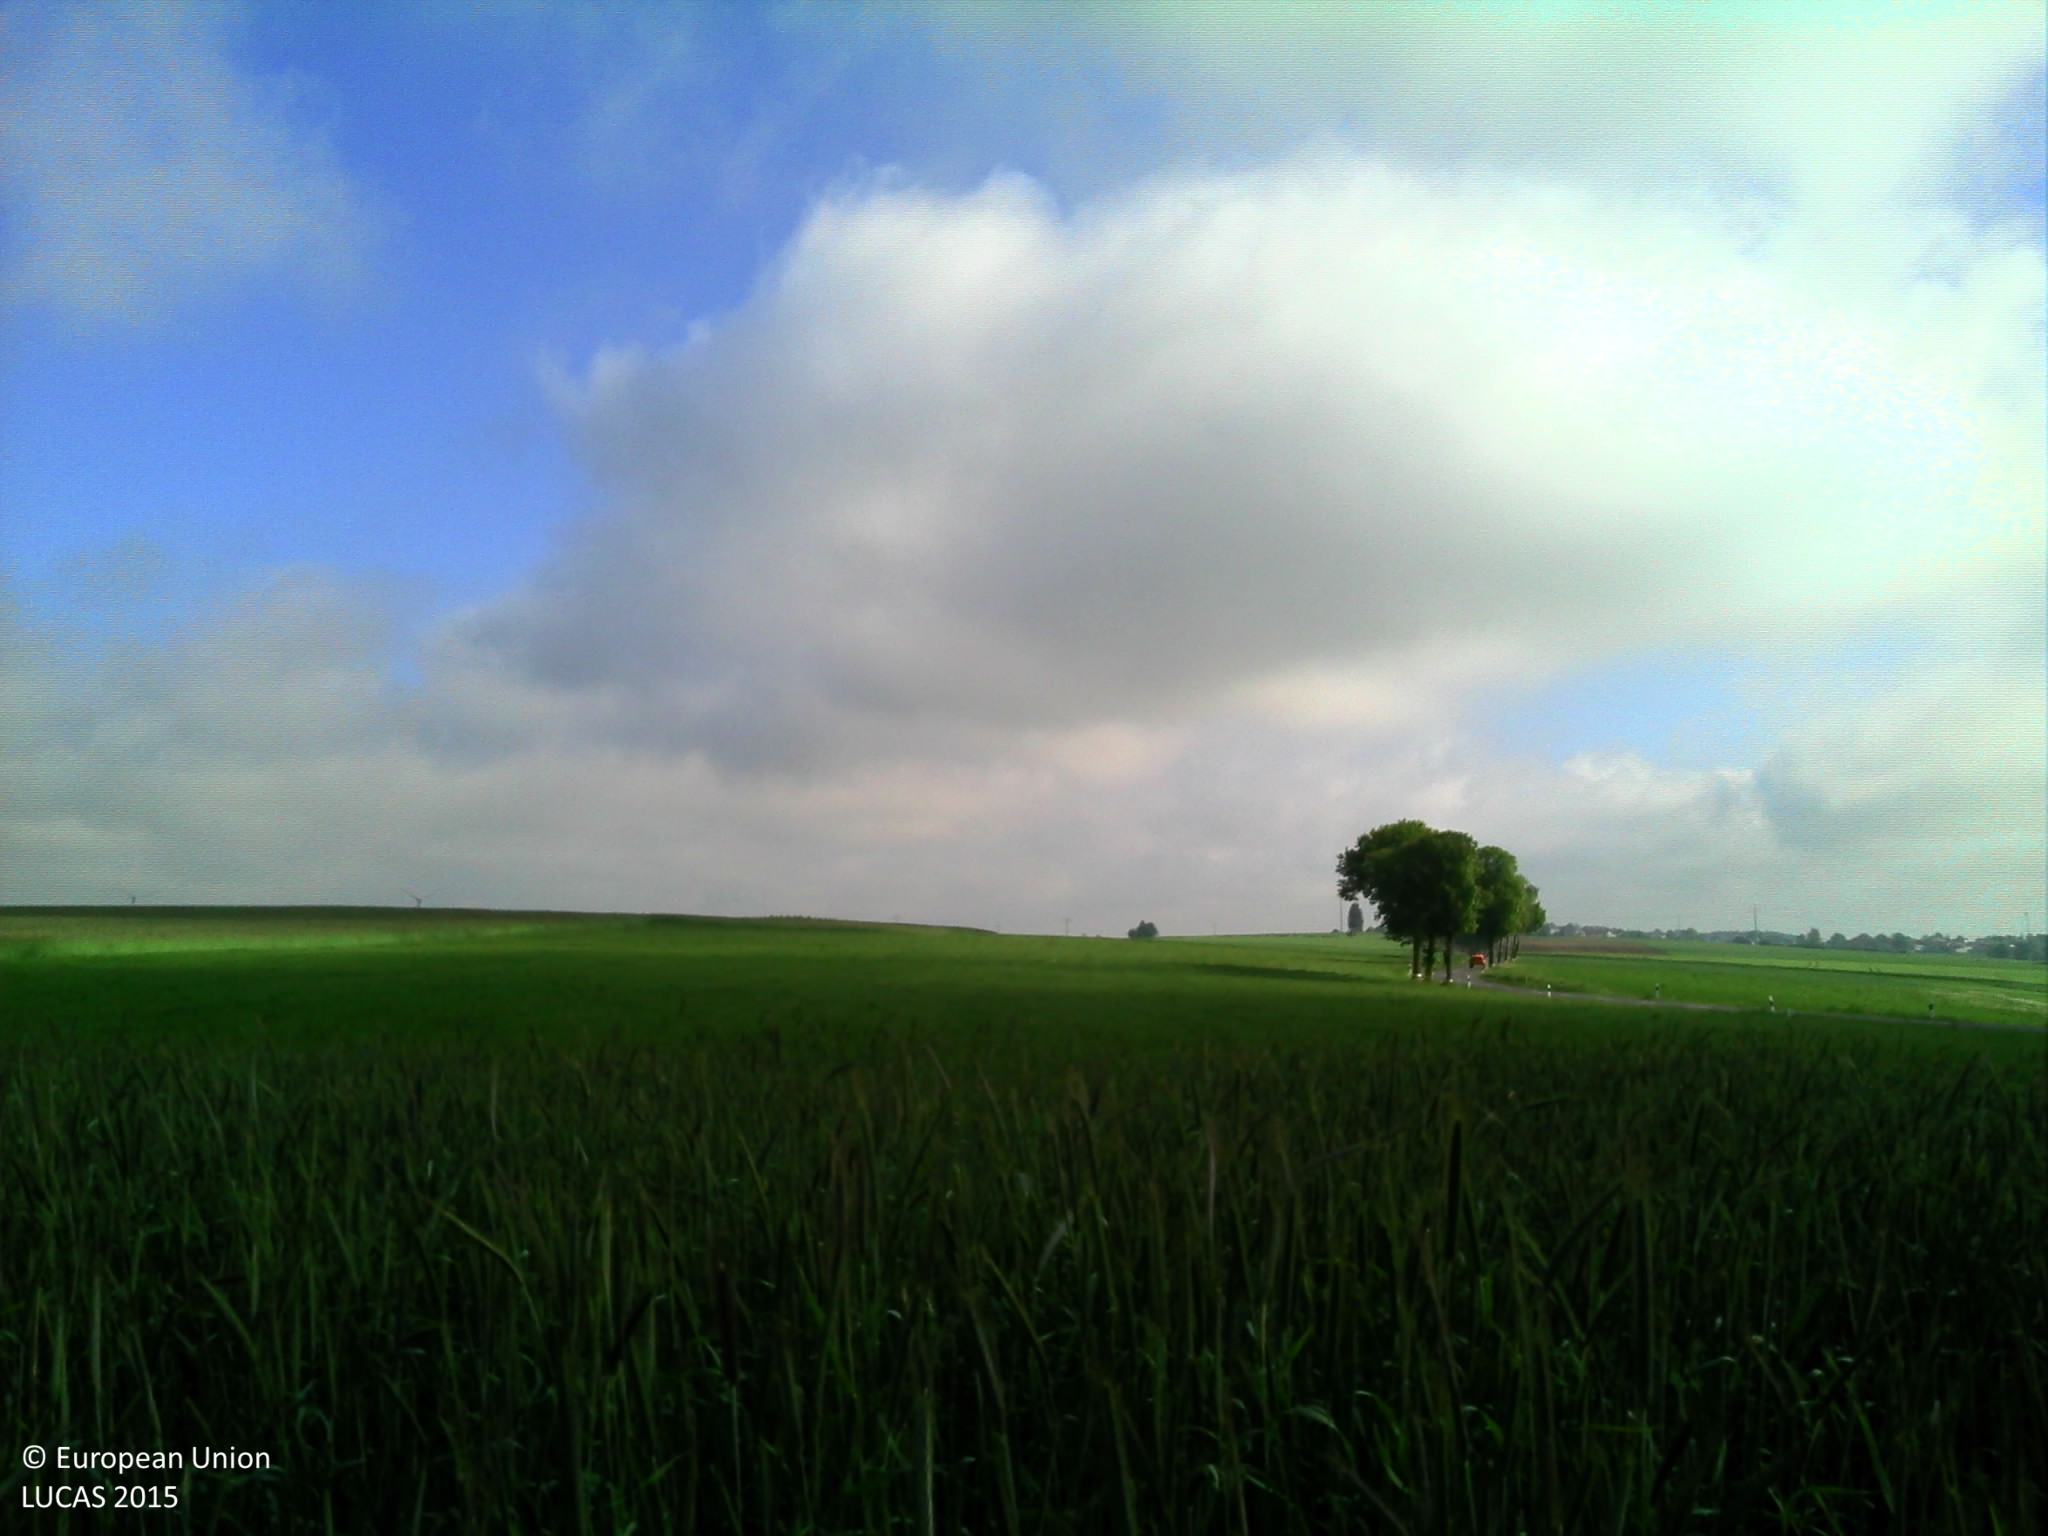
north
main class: Cropland
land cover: Barley
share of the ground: > 75 %
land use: Agriculture (excluding fallow land and kitchen gardens)
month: May
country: LU
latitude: 50.0797
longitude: 6.0444
